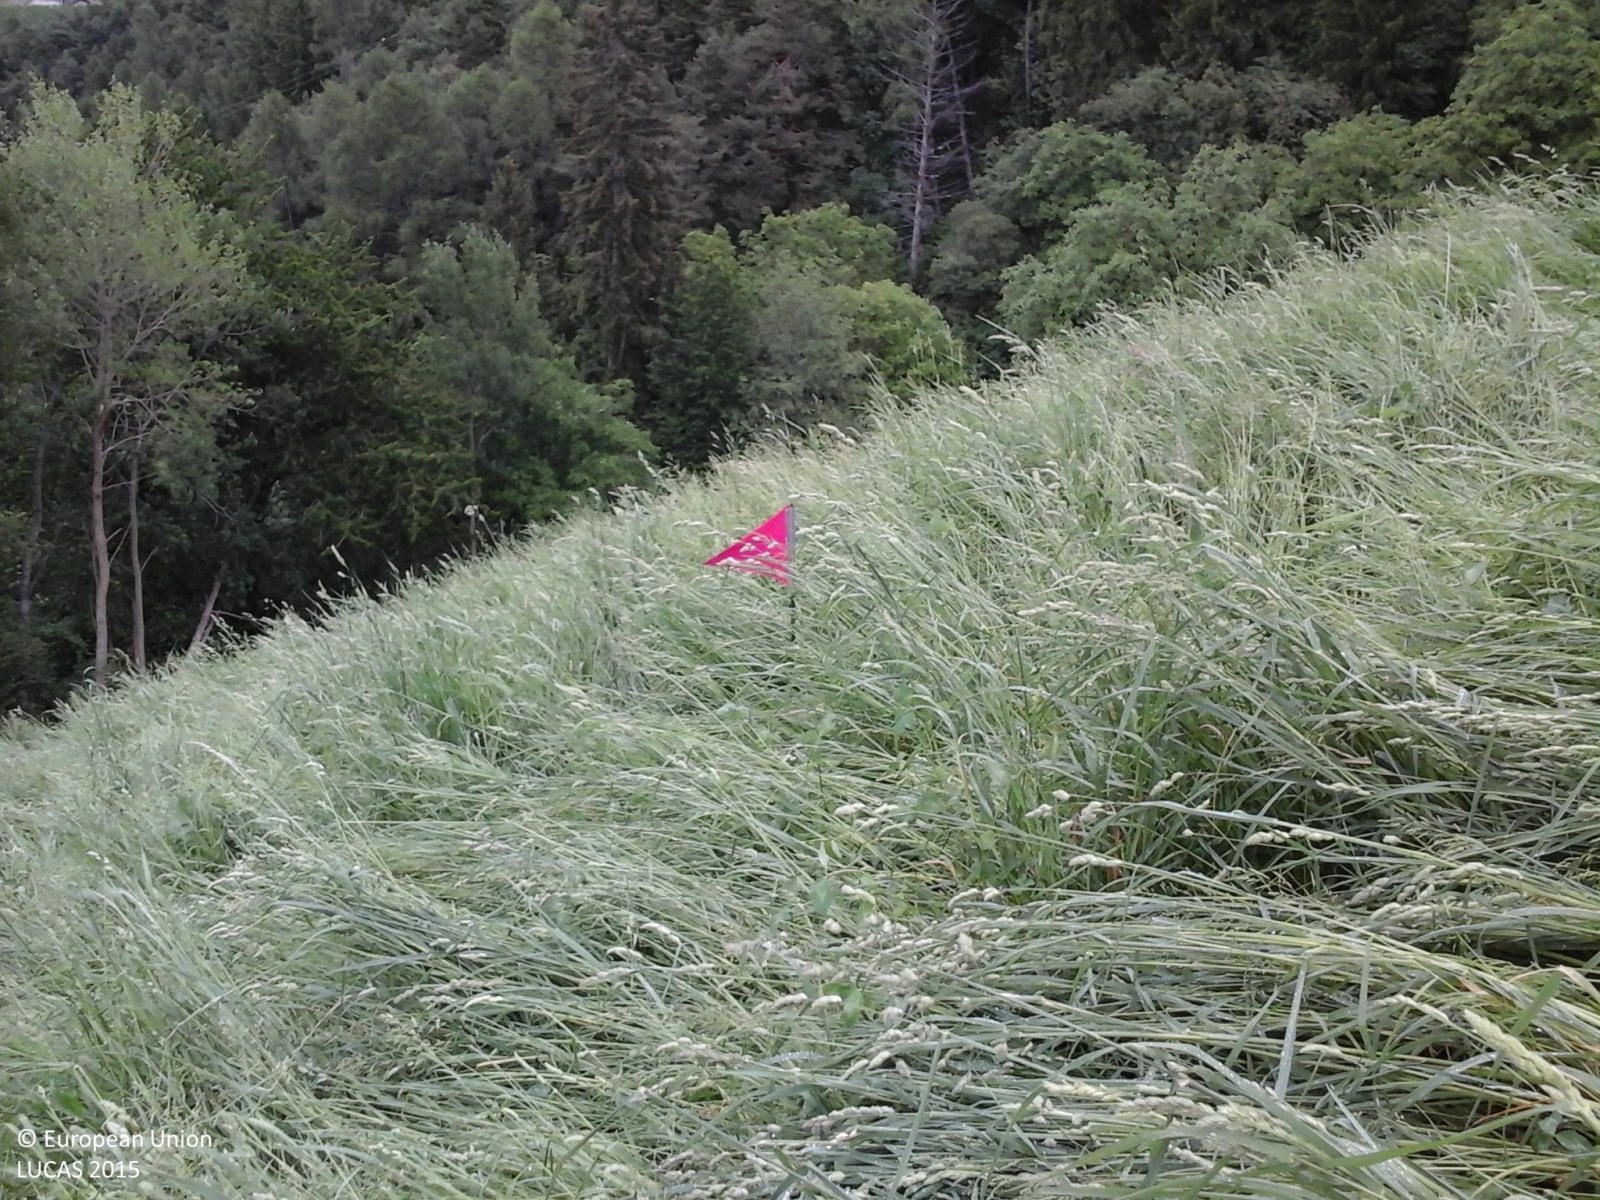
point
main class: Grassland
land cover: Grassland without tree/shrub cover
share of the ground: > 75 %
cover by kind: herbaceous plants 100 %
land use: Agriculture (excluding fallow land and kitchen gardens)
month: May
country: IT
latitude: 46.6522
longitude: 11.0572
